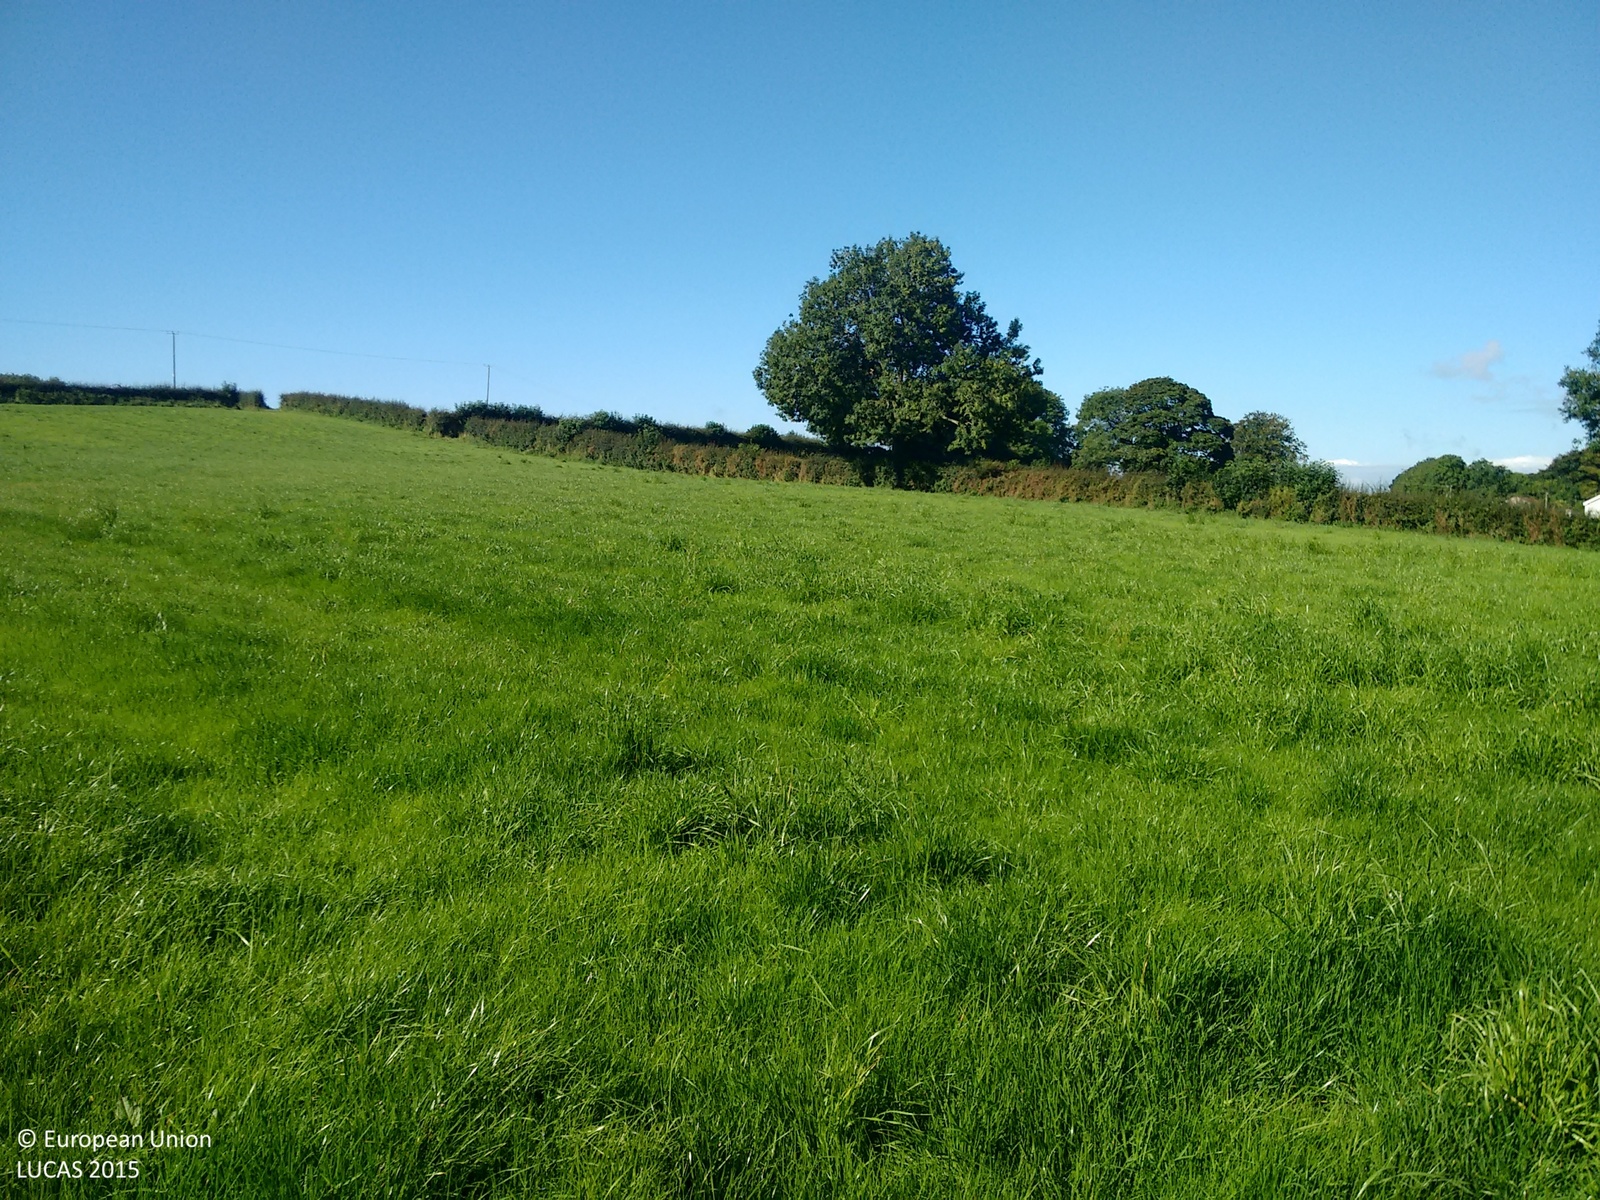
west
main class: Grassland
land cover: Grassland without tree/shrub cover
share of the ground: > 75 %
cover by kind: herbaceous plants 100 %
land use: Agriculture (excluding fallow land and kitchen gardens)
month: September
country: GB
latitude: 54.7374
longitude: -5.9660
